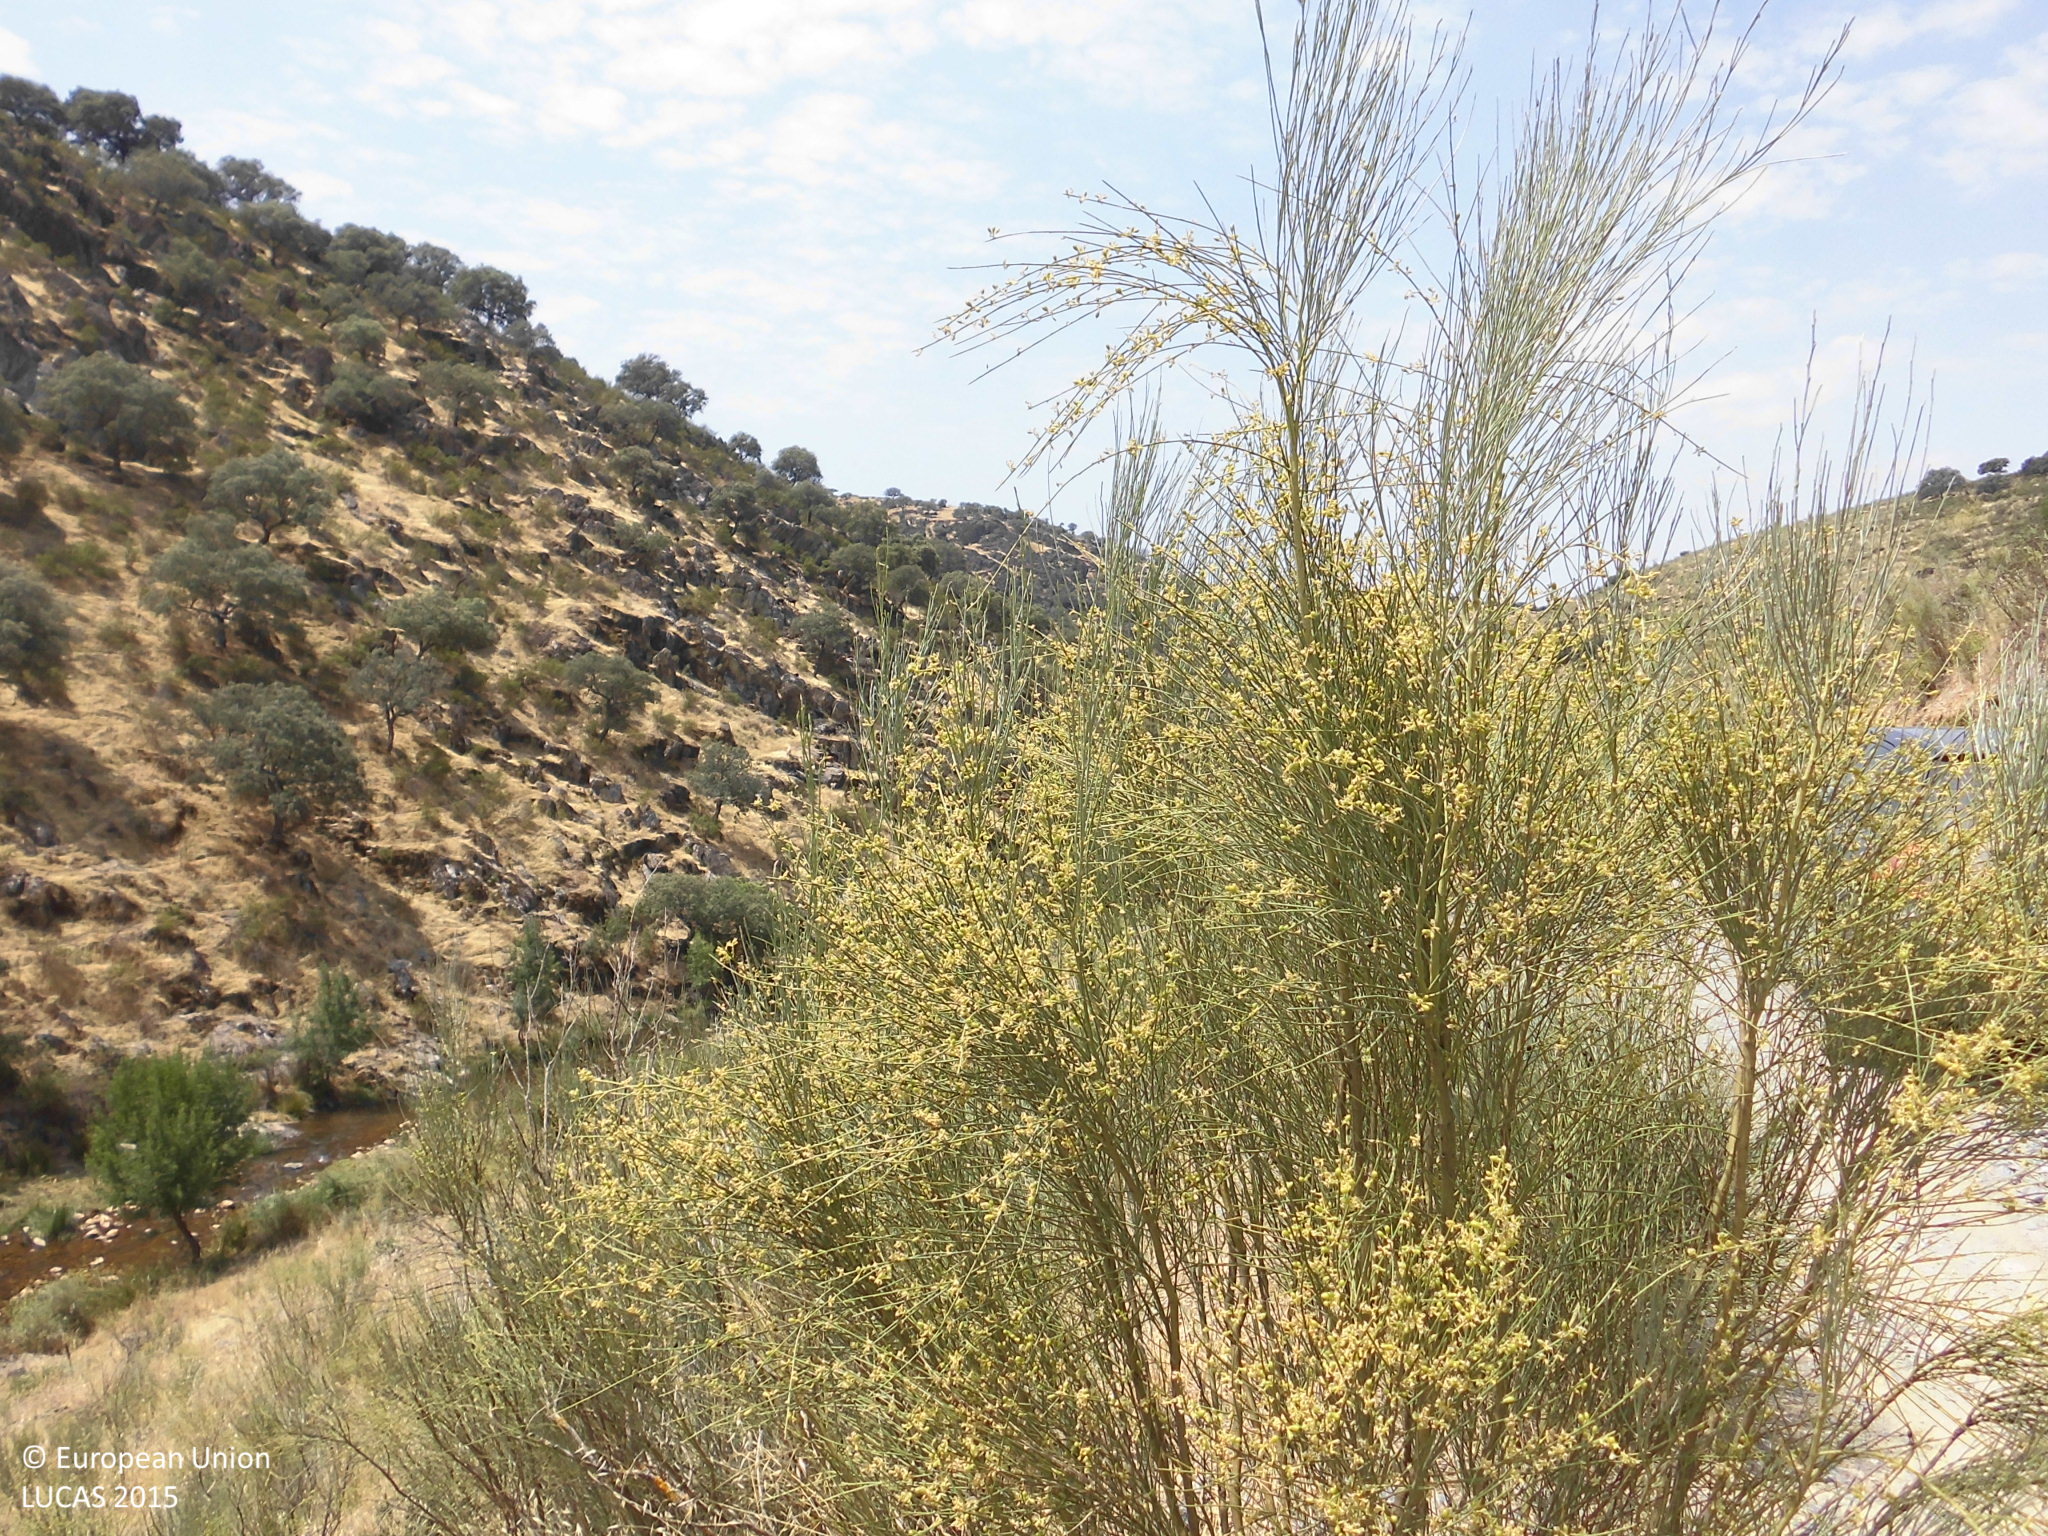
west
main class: Shrubland
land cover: Shrubland with sparse tree cover
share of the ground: 50 - 75 %
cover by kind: shrubs 50 %, herbaceous plants 45 %, broadleaved forest trees 5 %
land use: Agriculture (excluding fallow land and kitchen gardens)
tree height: > 5 m
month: June
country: ES
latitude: 39.5533
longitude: -5.5435
